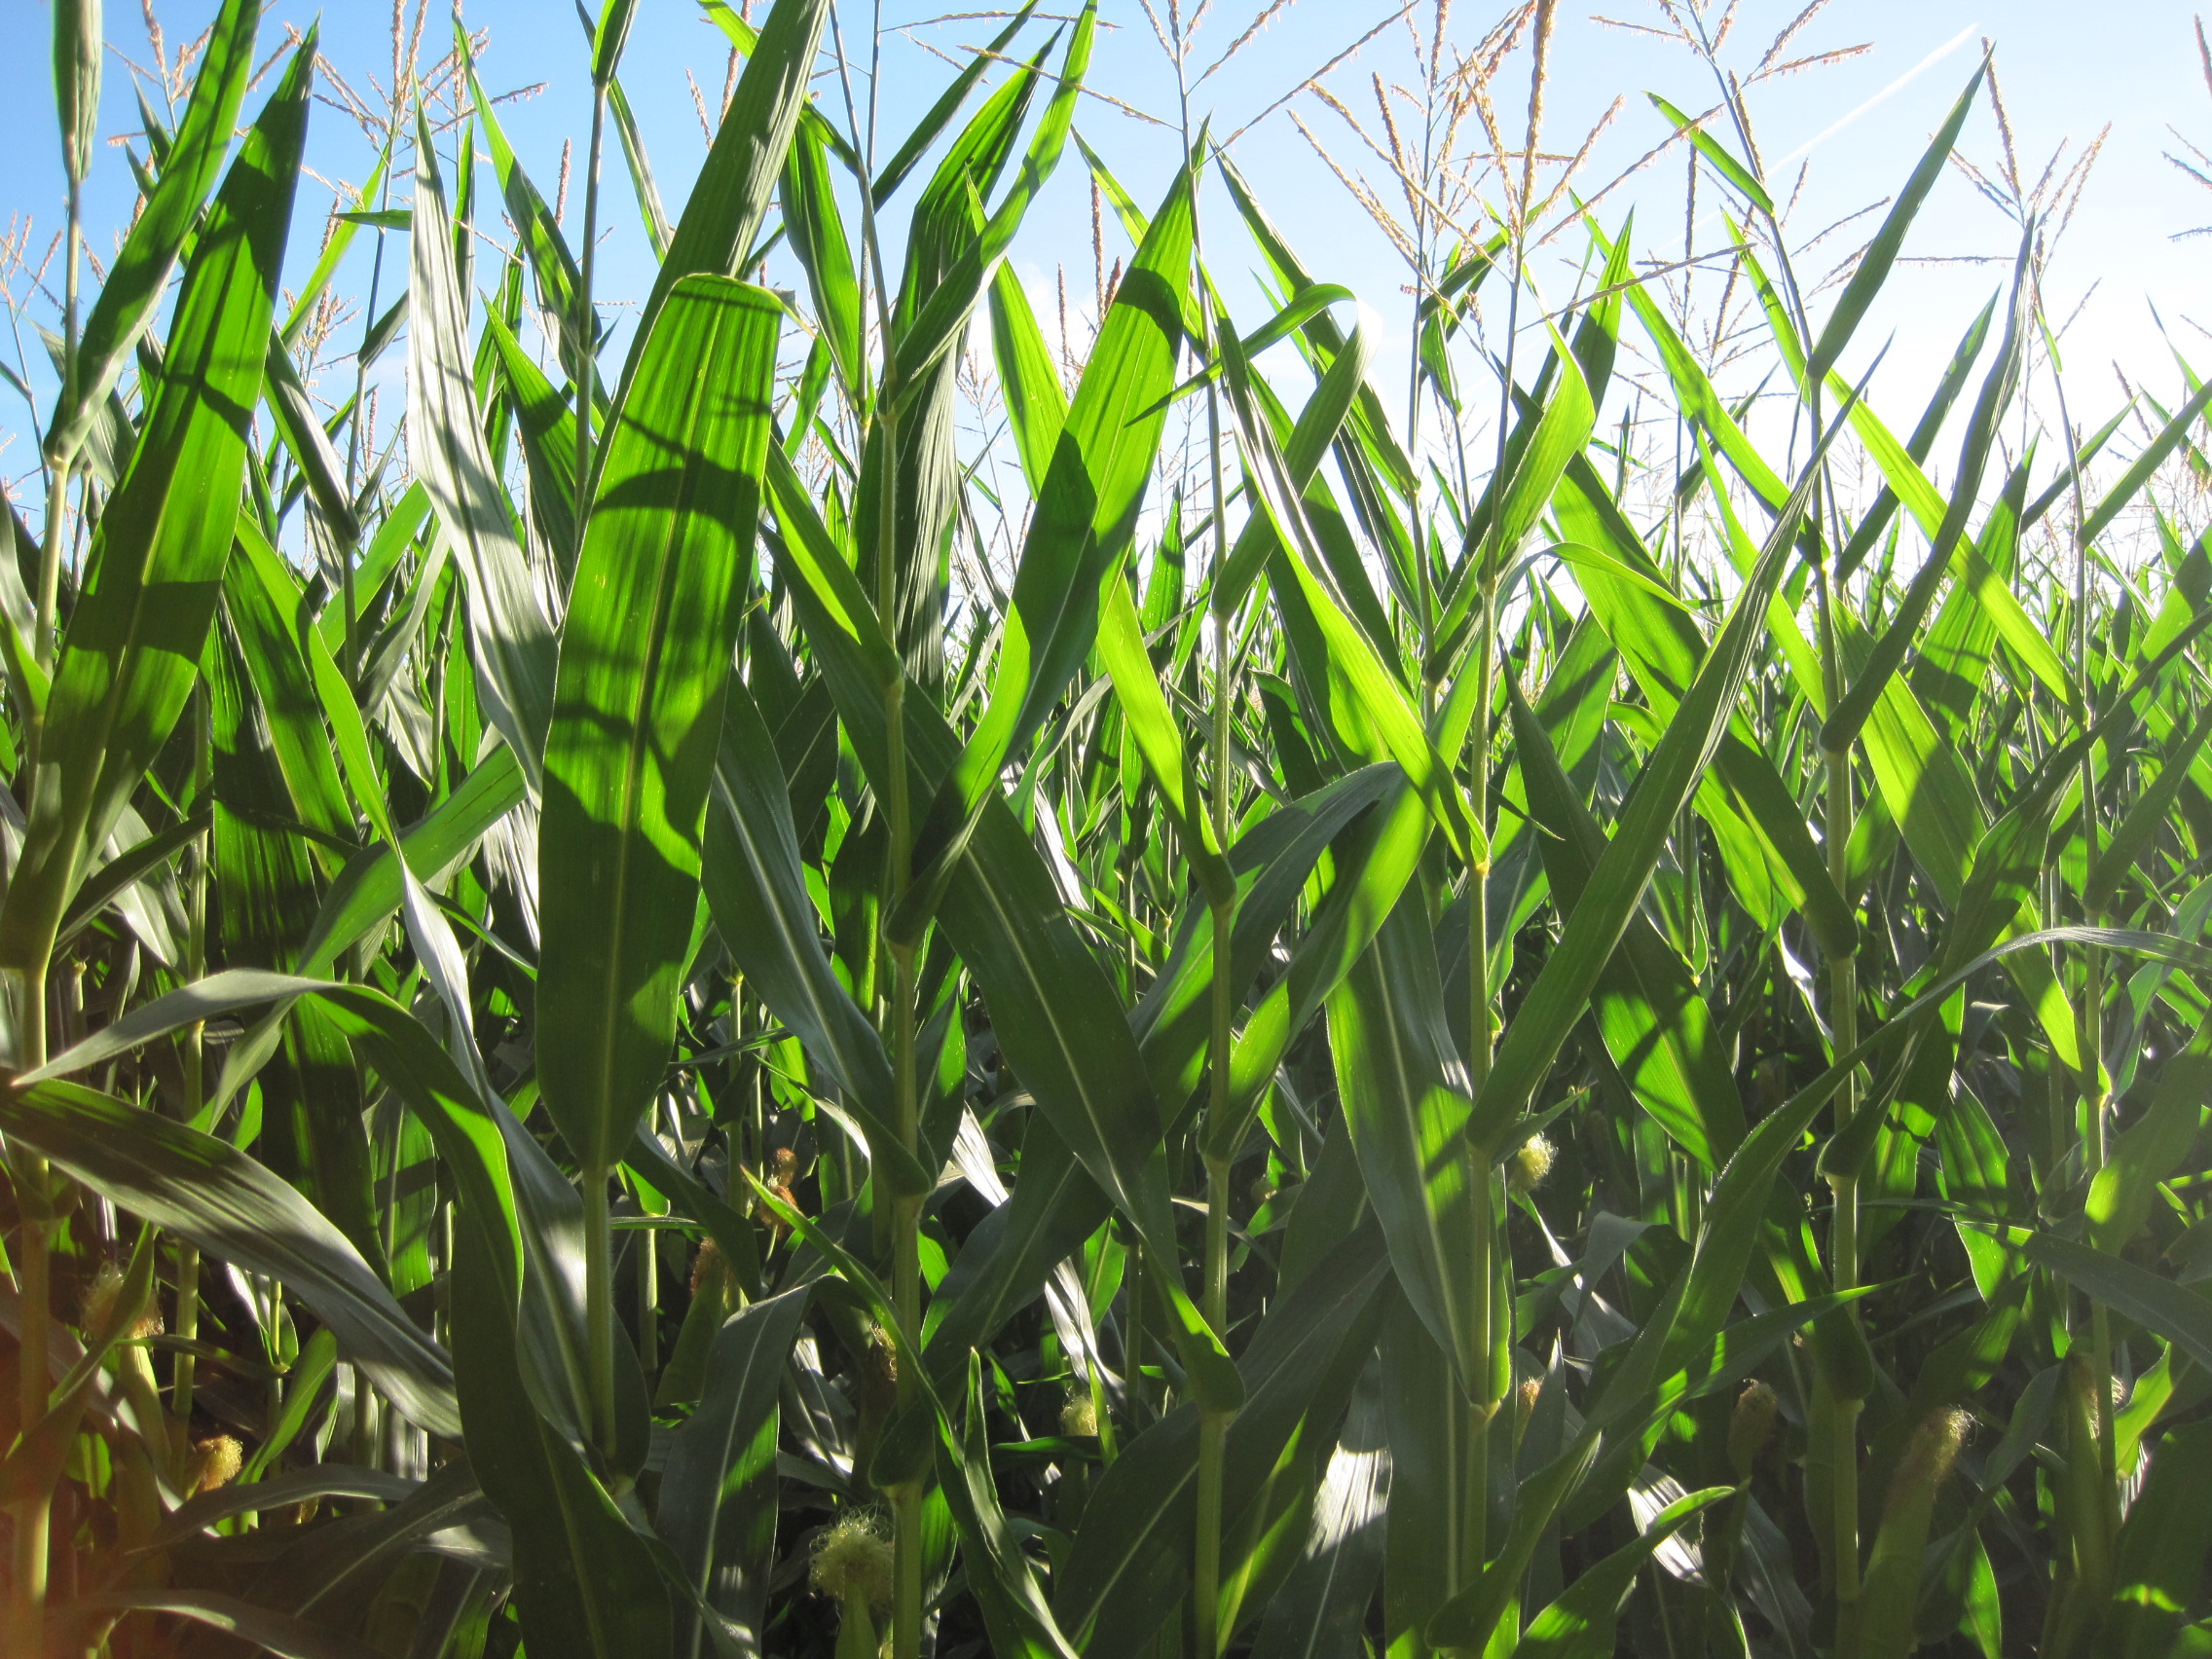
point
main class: Cropland
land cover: Maize
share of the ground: > 75 %
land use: Agriculture (excluding fallow land and kitchen gardens)
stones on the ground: < 10 %
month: July
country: ES
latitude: 42.0050
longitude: -5.6051
